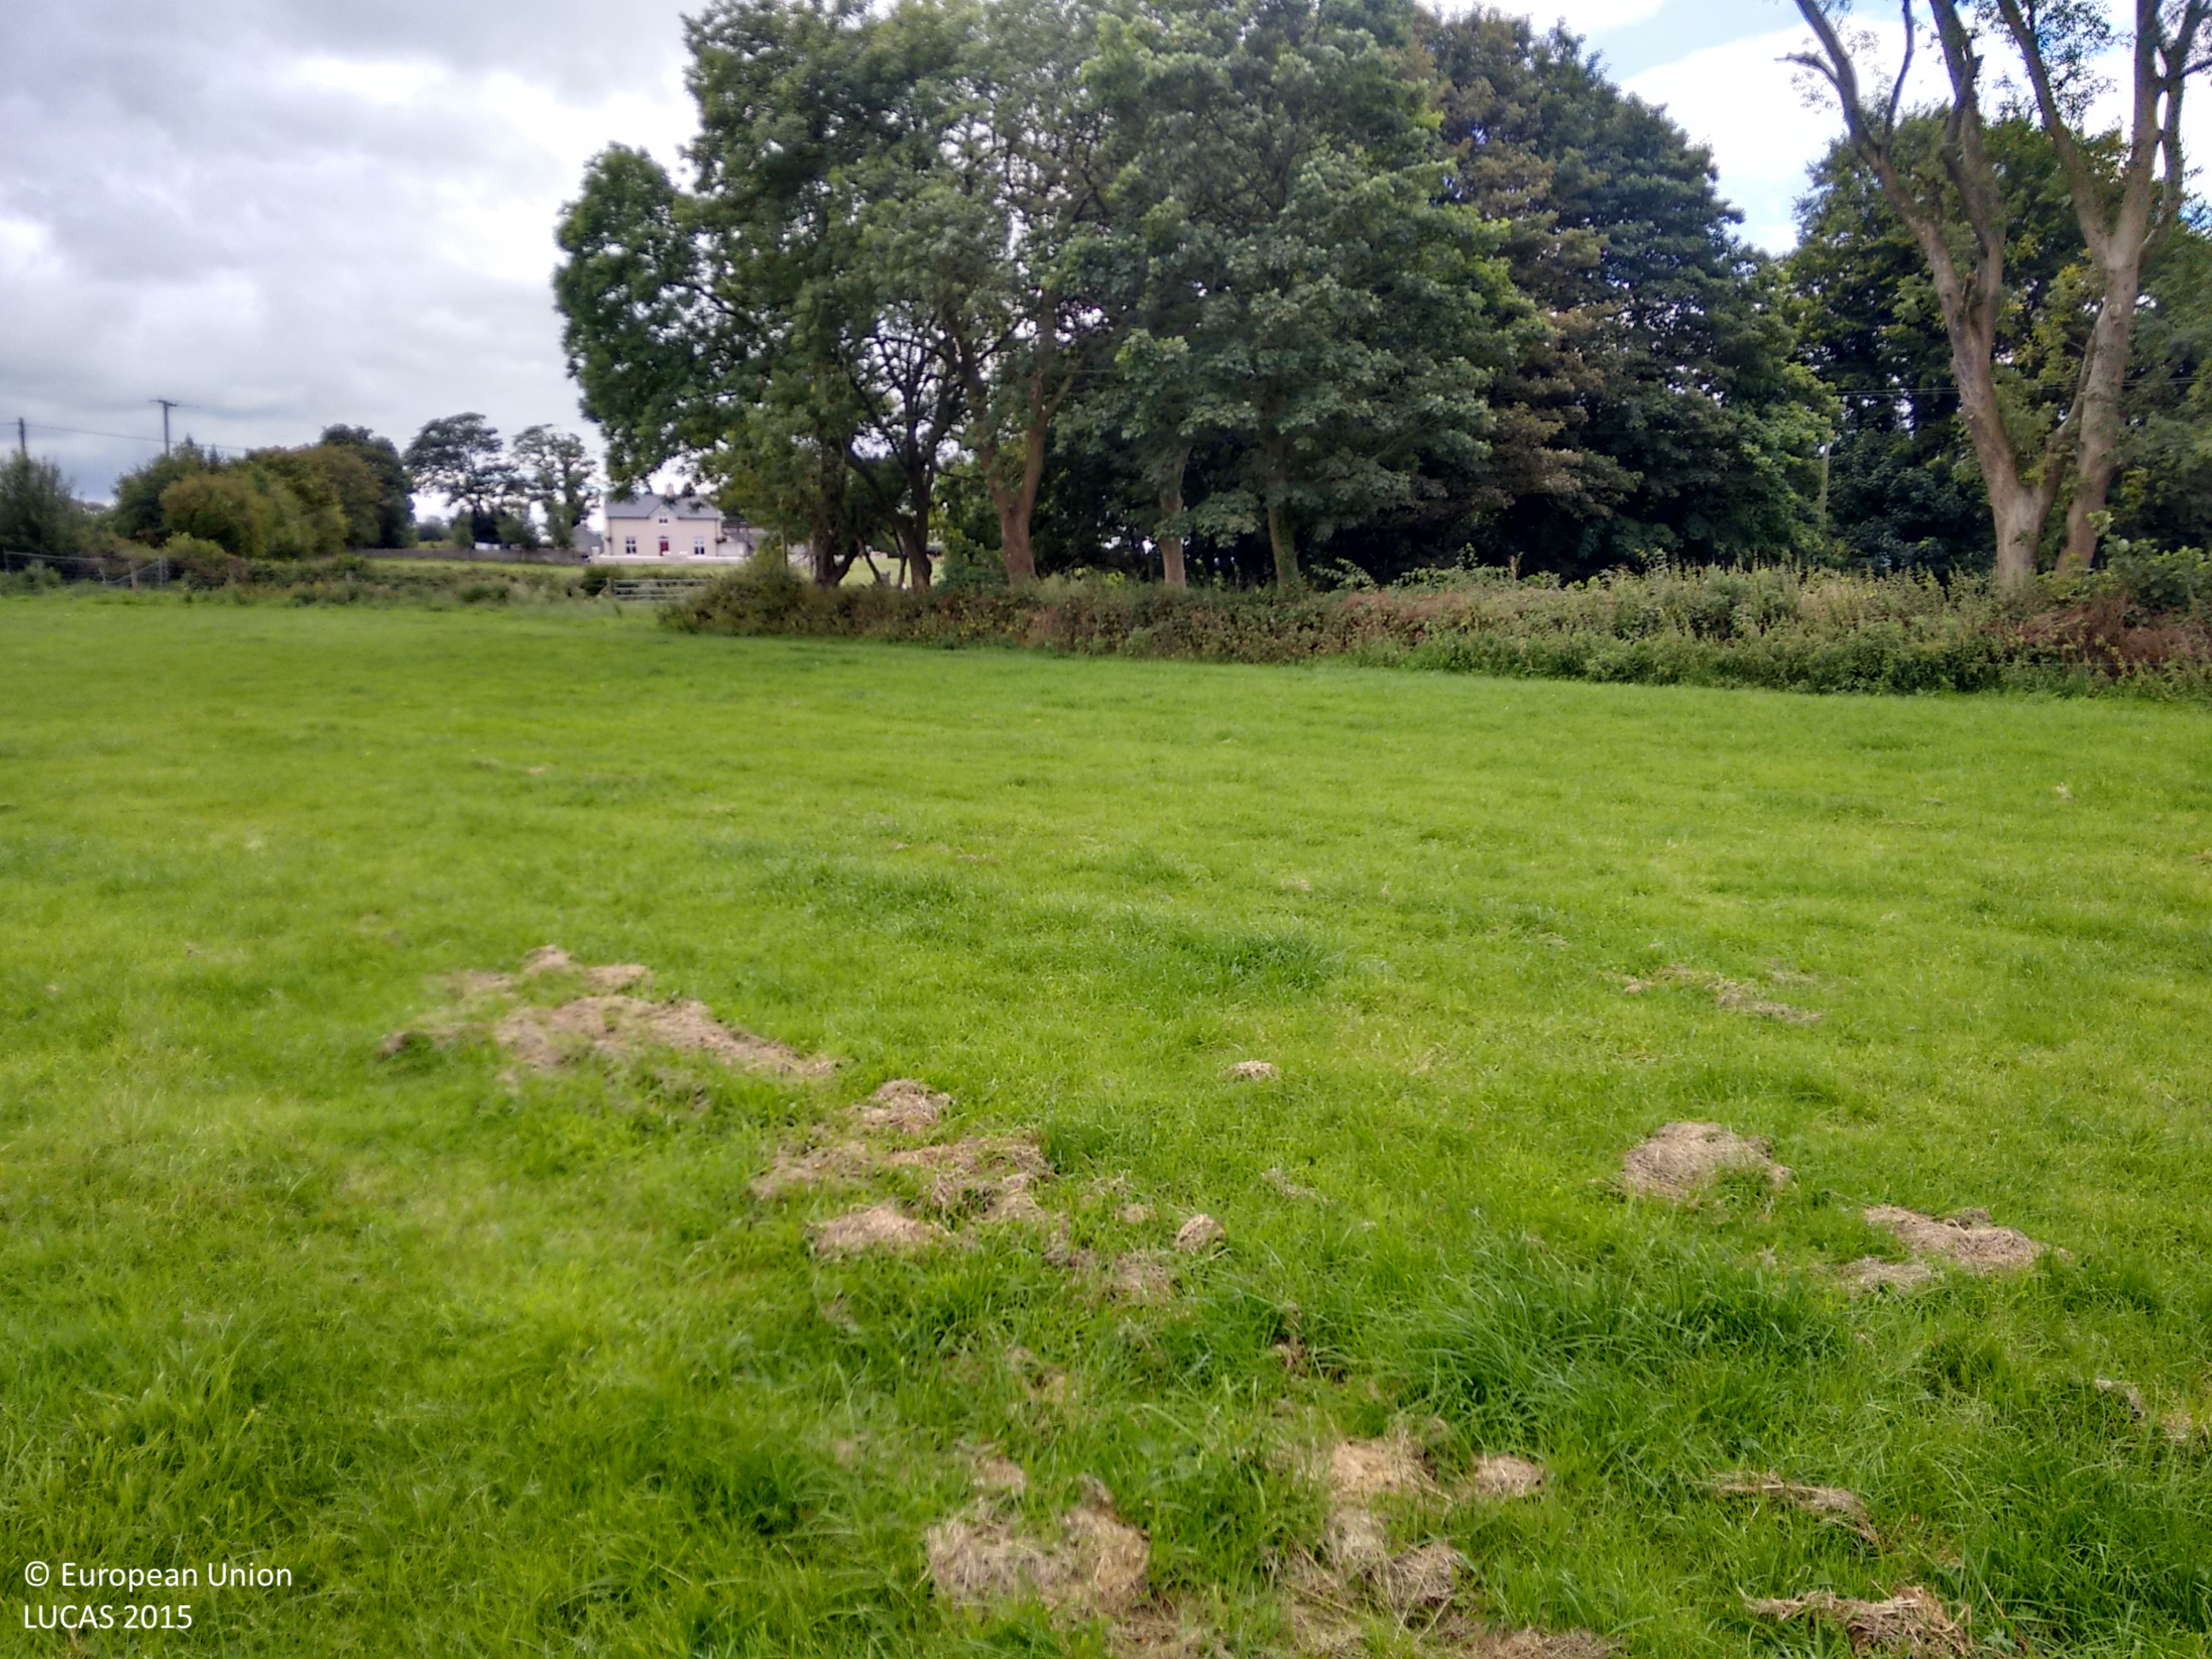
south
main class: Grassland
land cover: Grassland without tree/shrub cover
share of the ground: > 75 %
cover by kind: herbaceous plants 100 %
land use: Agriculture (excluding fallow land and kitchen gardens)
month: September
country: IE
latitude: 52.5404
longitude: -8.5526
